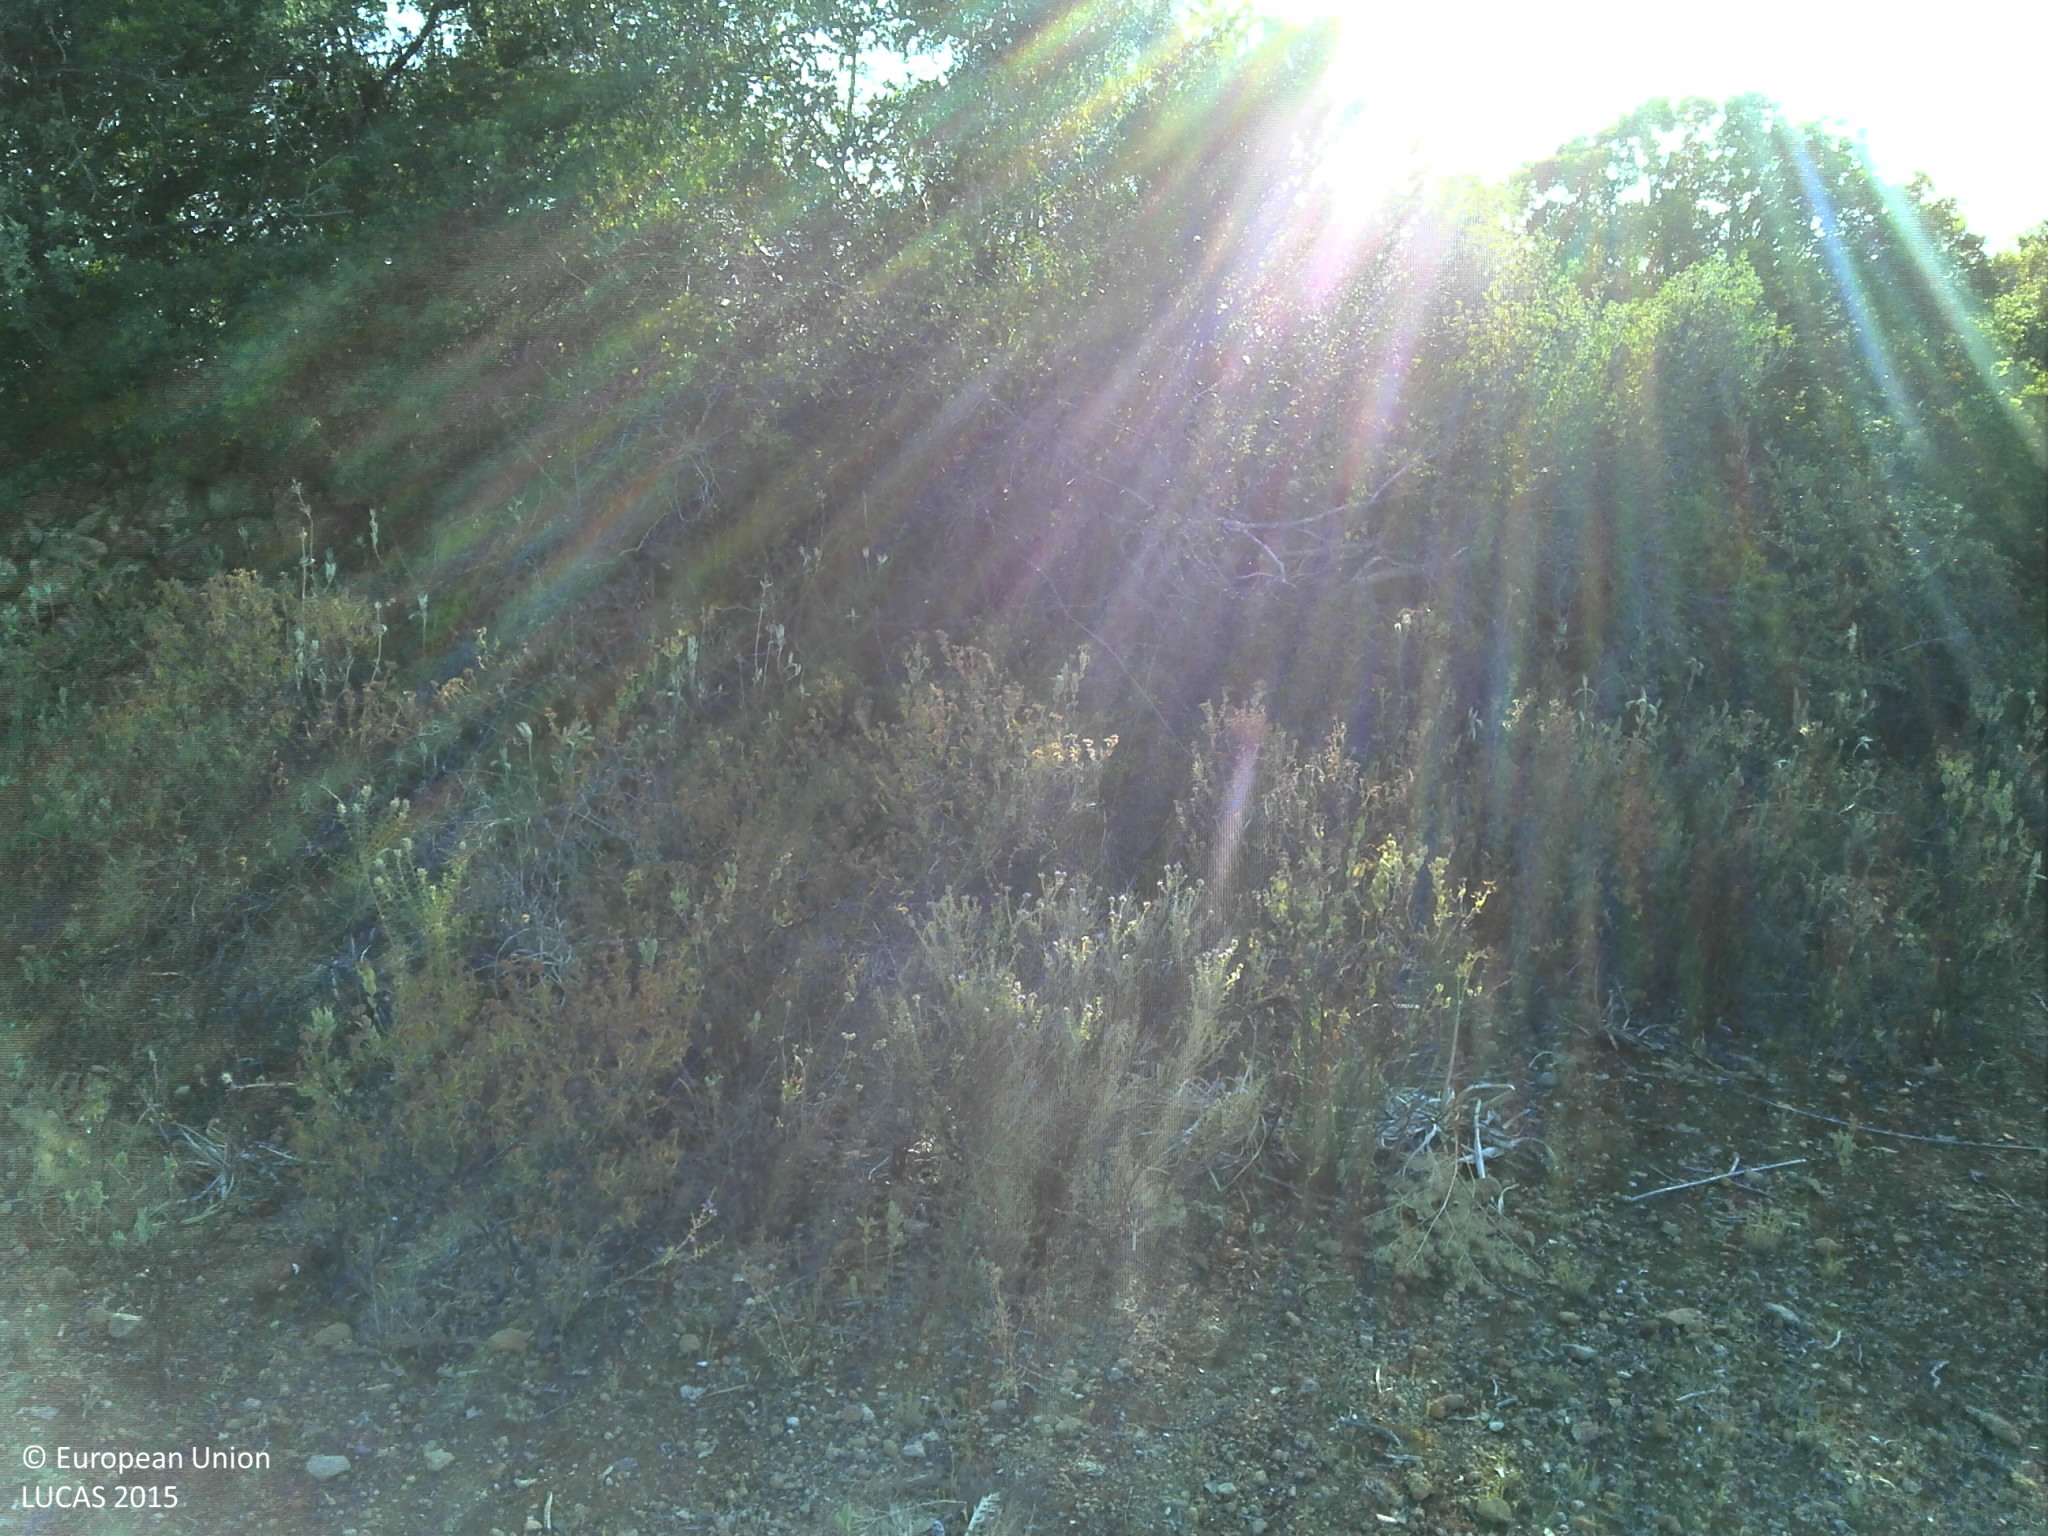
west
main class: Woodland
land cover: Broadleaved woodland
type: broadleaved evergreen forest
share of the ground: 10 - 25 %
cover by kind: unconsolidated bare surface 50 %, broadleaved forest trees 25 %, herbaceous plants 25 %
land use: Forestry
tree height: < 5 m
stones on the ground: < 10 %
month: June
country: PT
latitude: 37.0736
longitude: -7.7895
